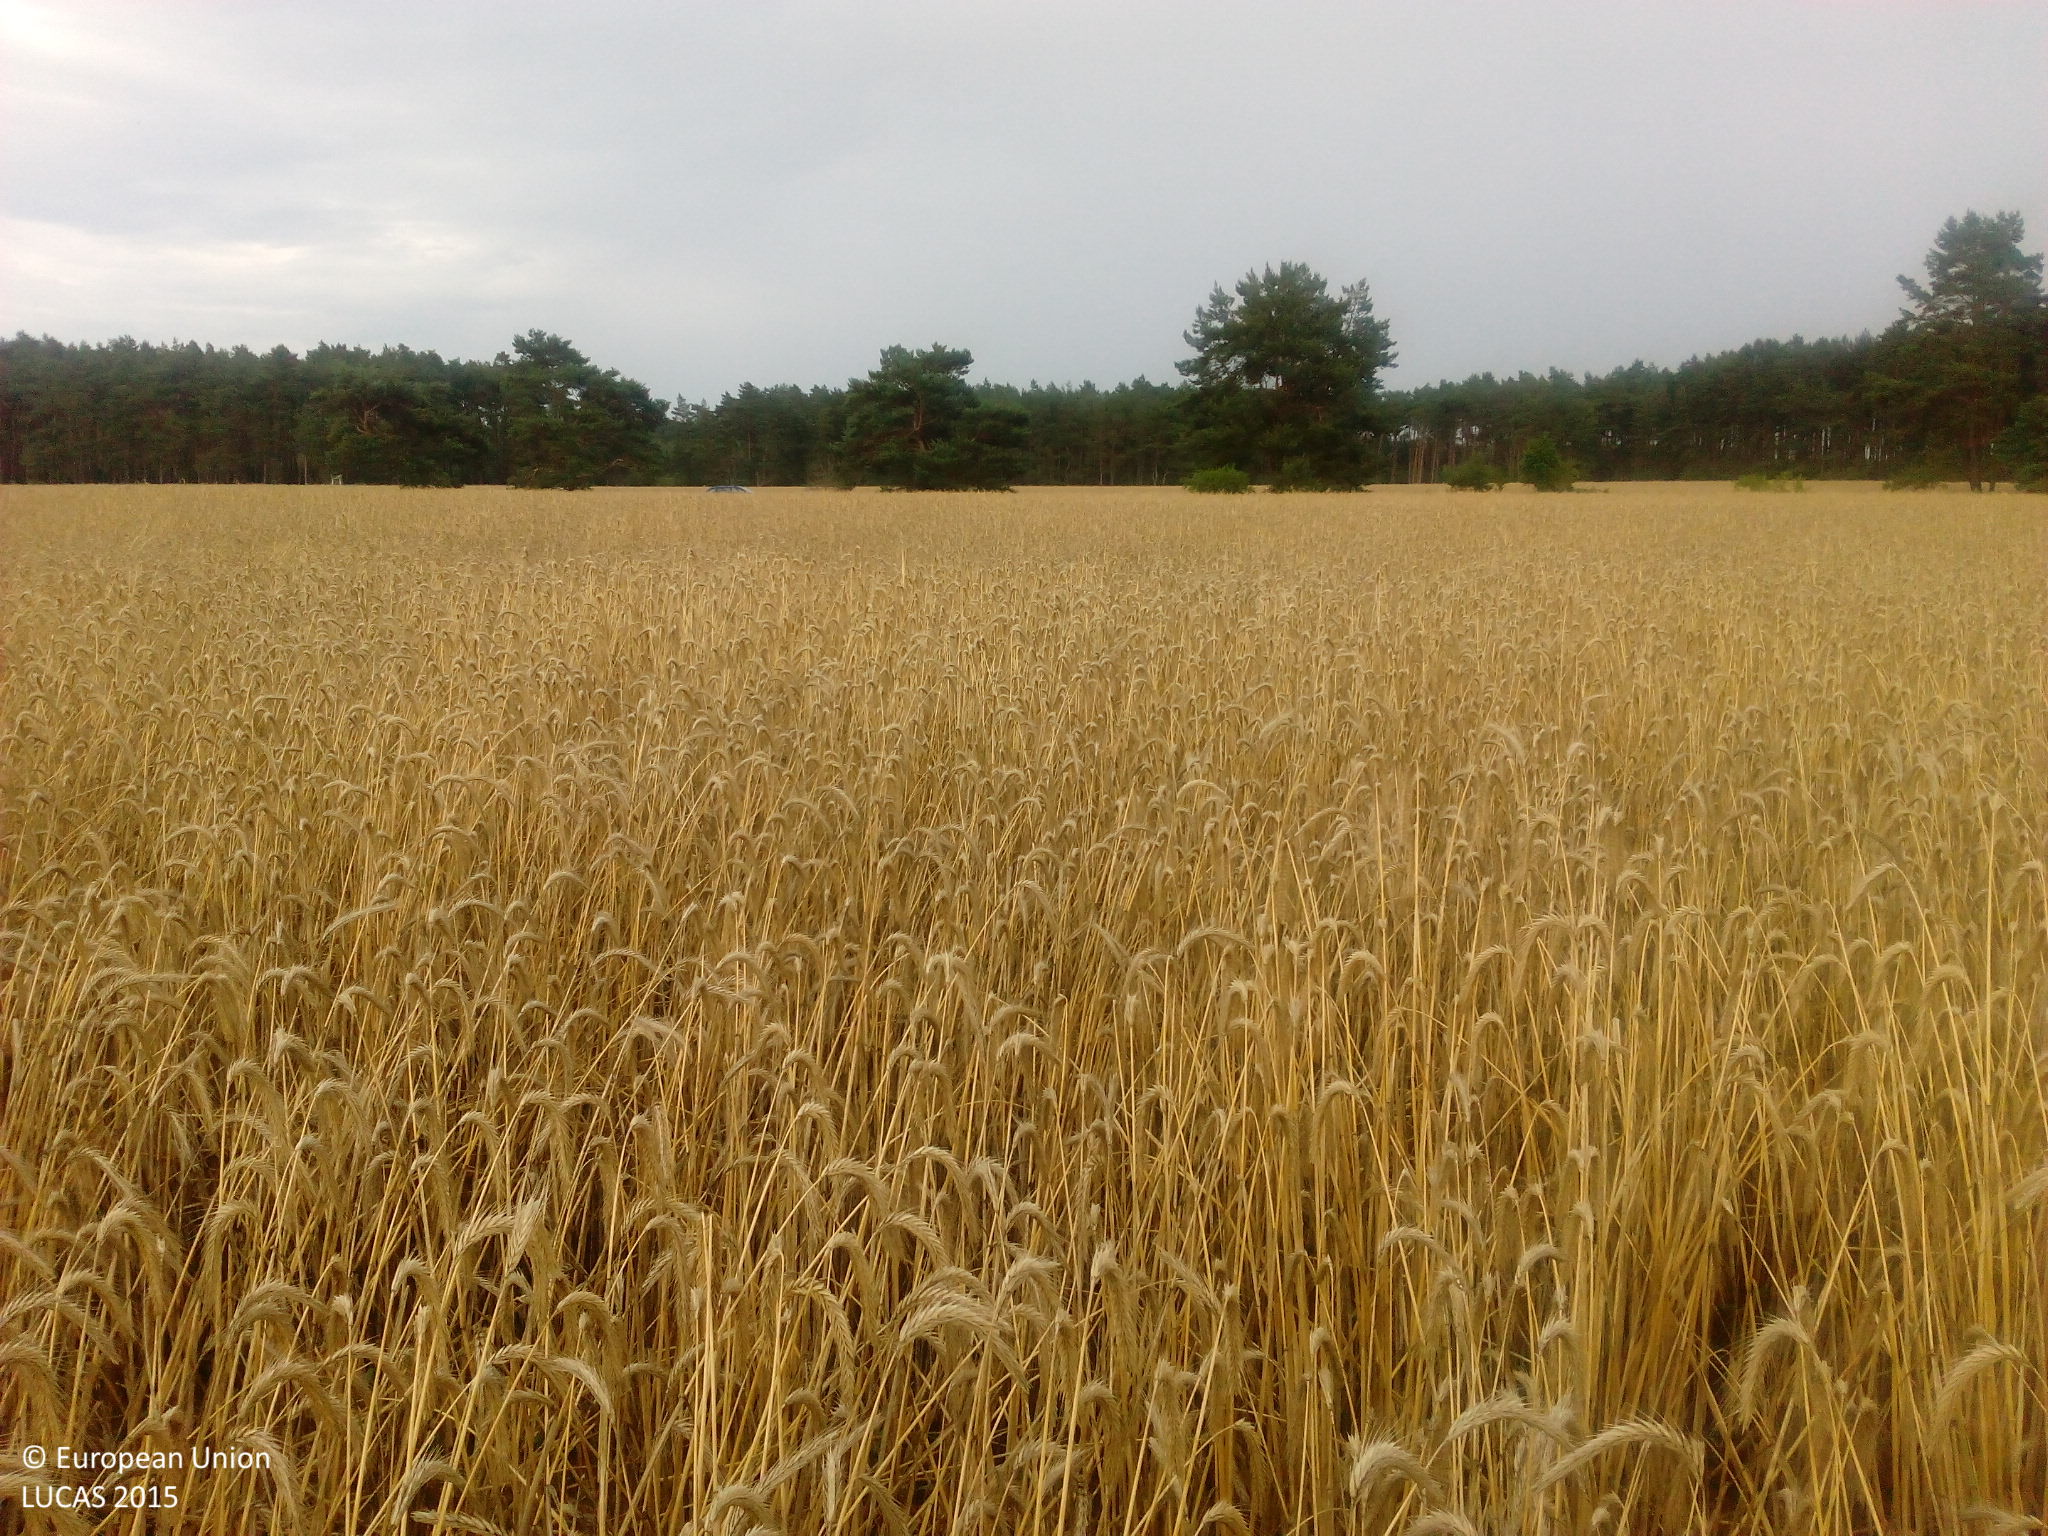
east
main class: Cropland
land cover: Rye
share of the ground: > 75 %
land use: Agriculture (excluding fallow land and kitchen gardens)
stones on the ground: < 10 %
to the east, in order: Rye; Grass margins; Paved roads, cycling and walking lanes; Grassland with sparse tree/shrub cover; Rye
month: July
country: DE
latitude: 51.9980
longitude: 12.1698
